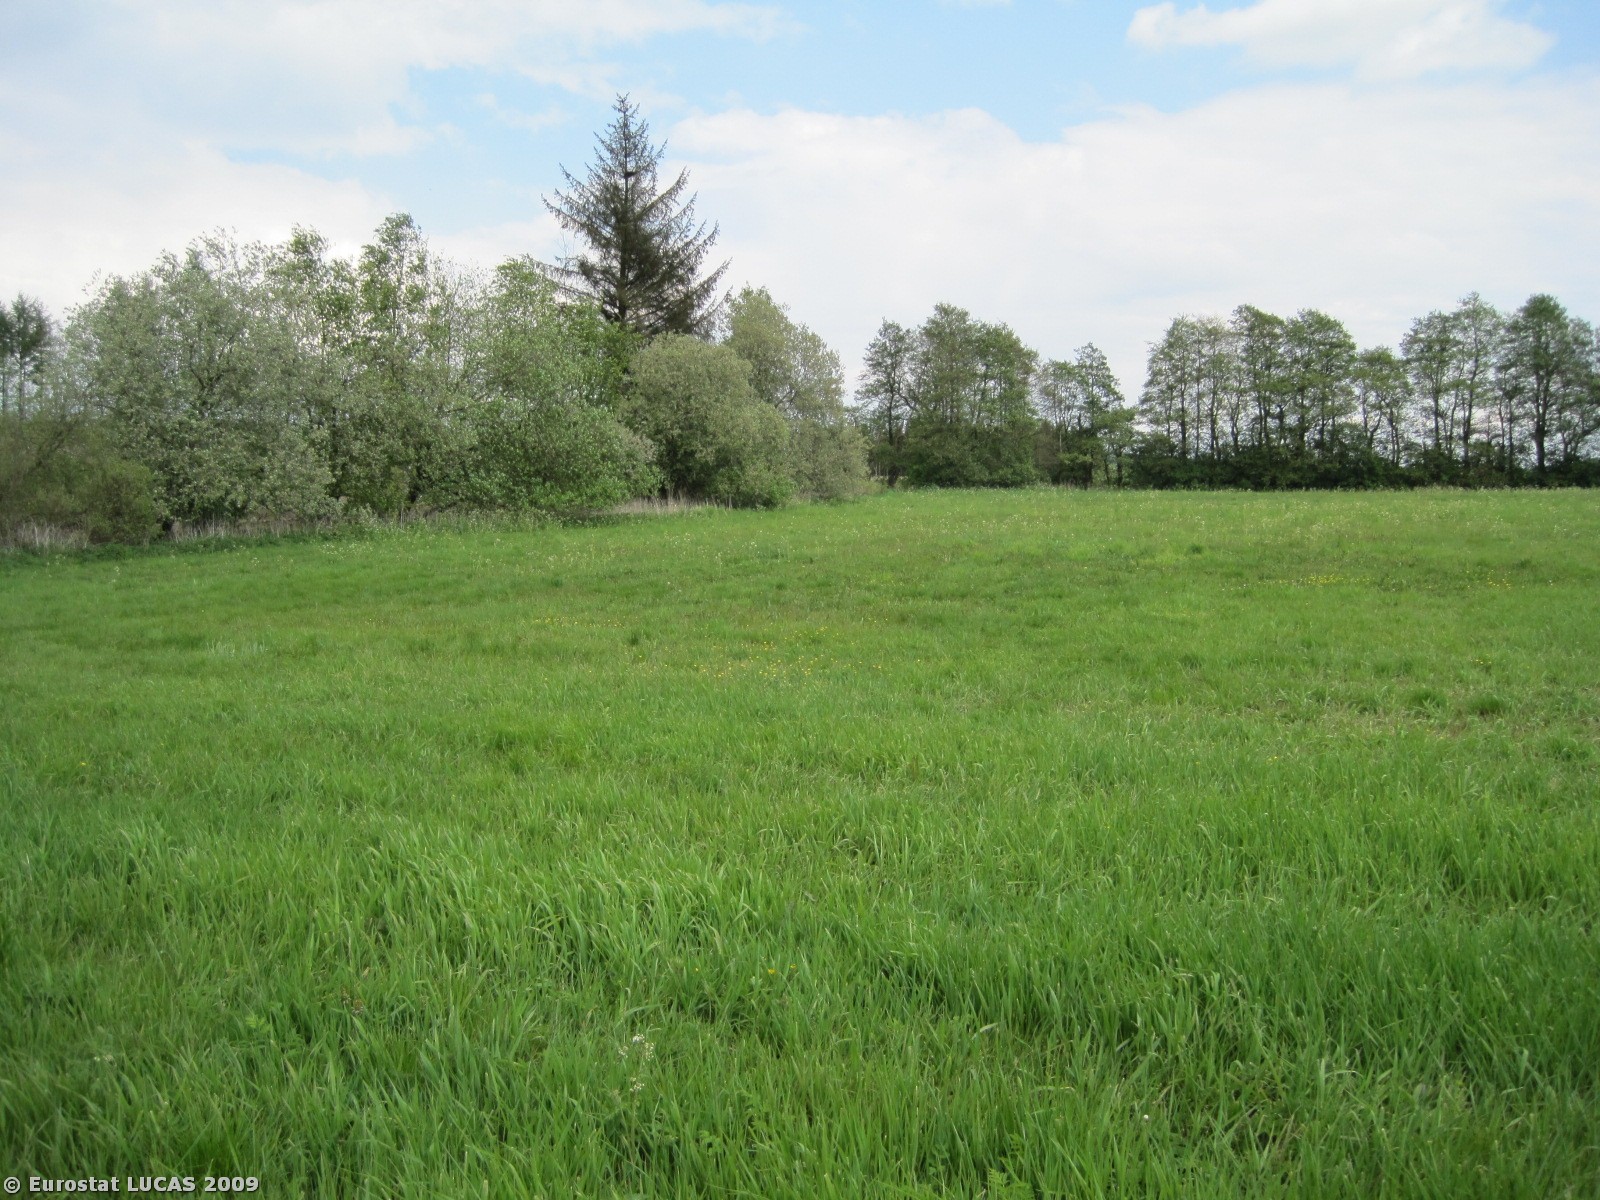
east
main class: Wetlands
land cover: Inland marshes
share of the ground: > 75 %
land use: Unused
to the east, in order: Inland marshes; Grassland without tree/shrub cover; Fences; Grass margins; Ditches and canals; Grass margins; Grassland without tree/shrub cover; Grass margins; Abandoned hedges; Ditches and canals; Rivers and streams; Abandoned hedges; Grass margins; Grassland without tree/shrub cover
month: May
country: DK
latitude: 56.3852
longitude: 9.7250
